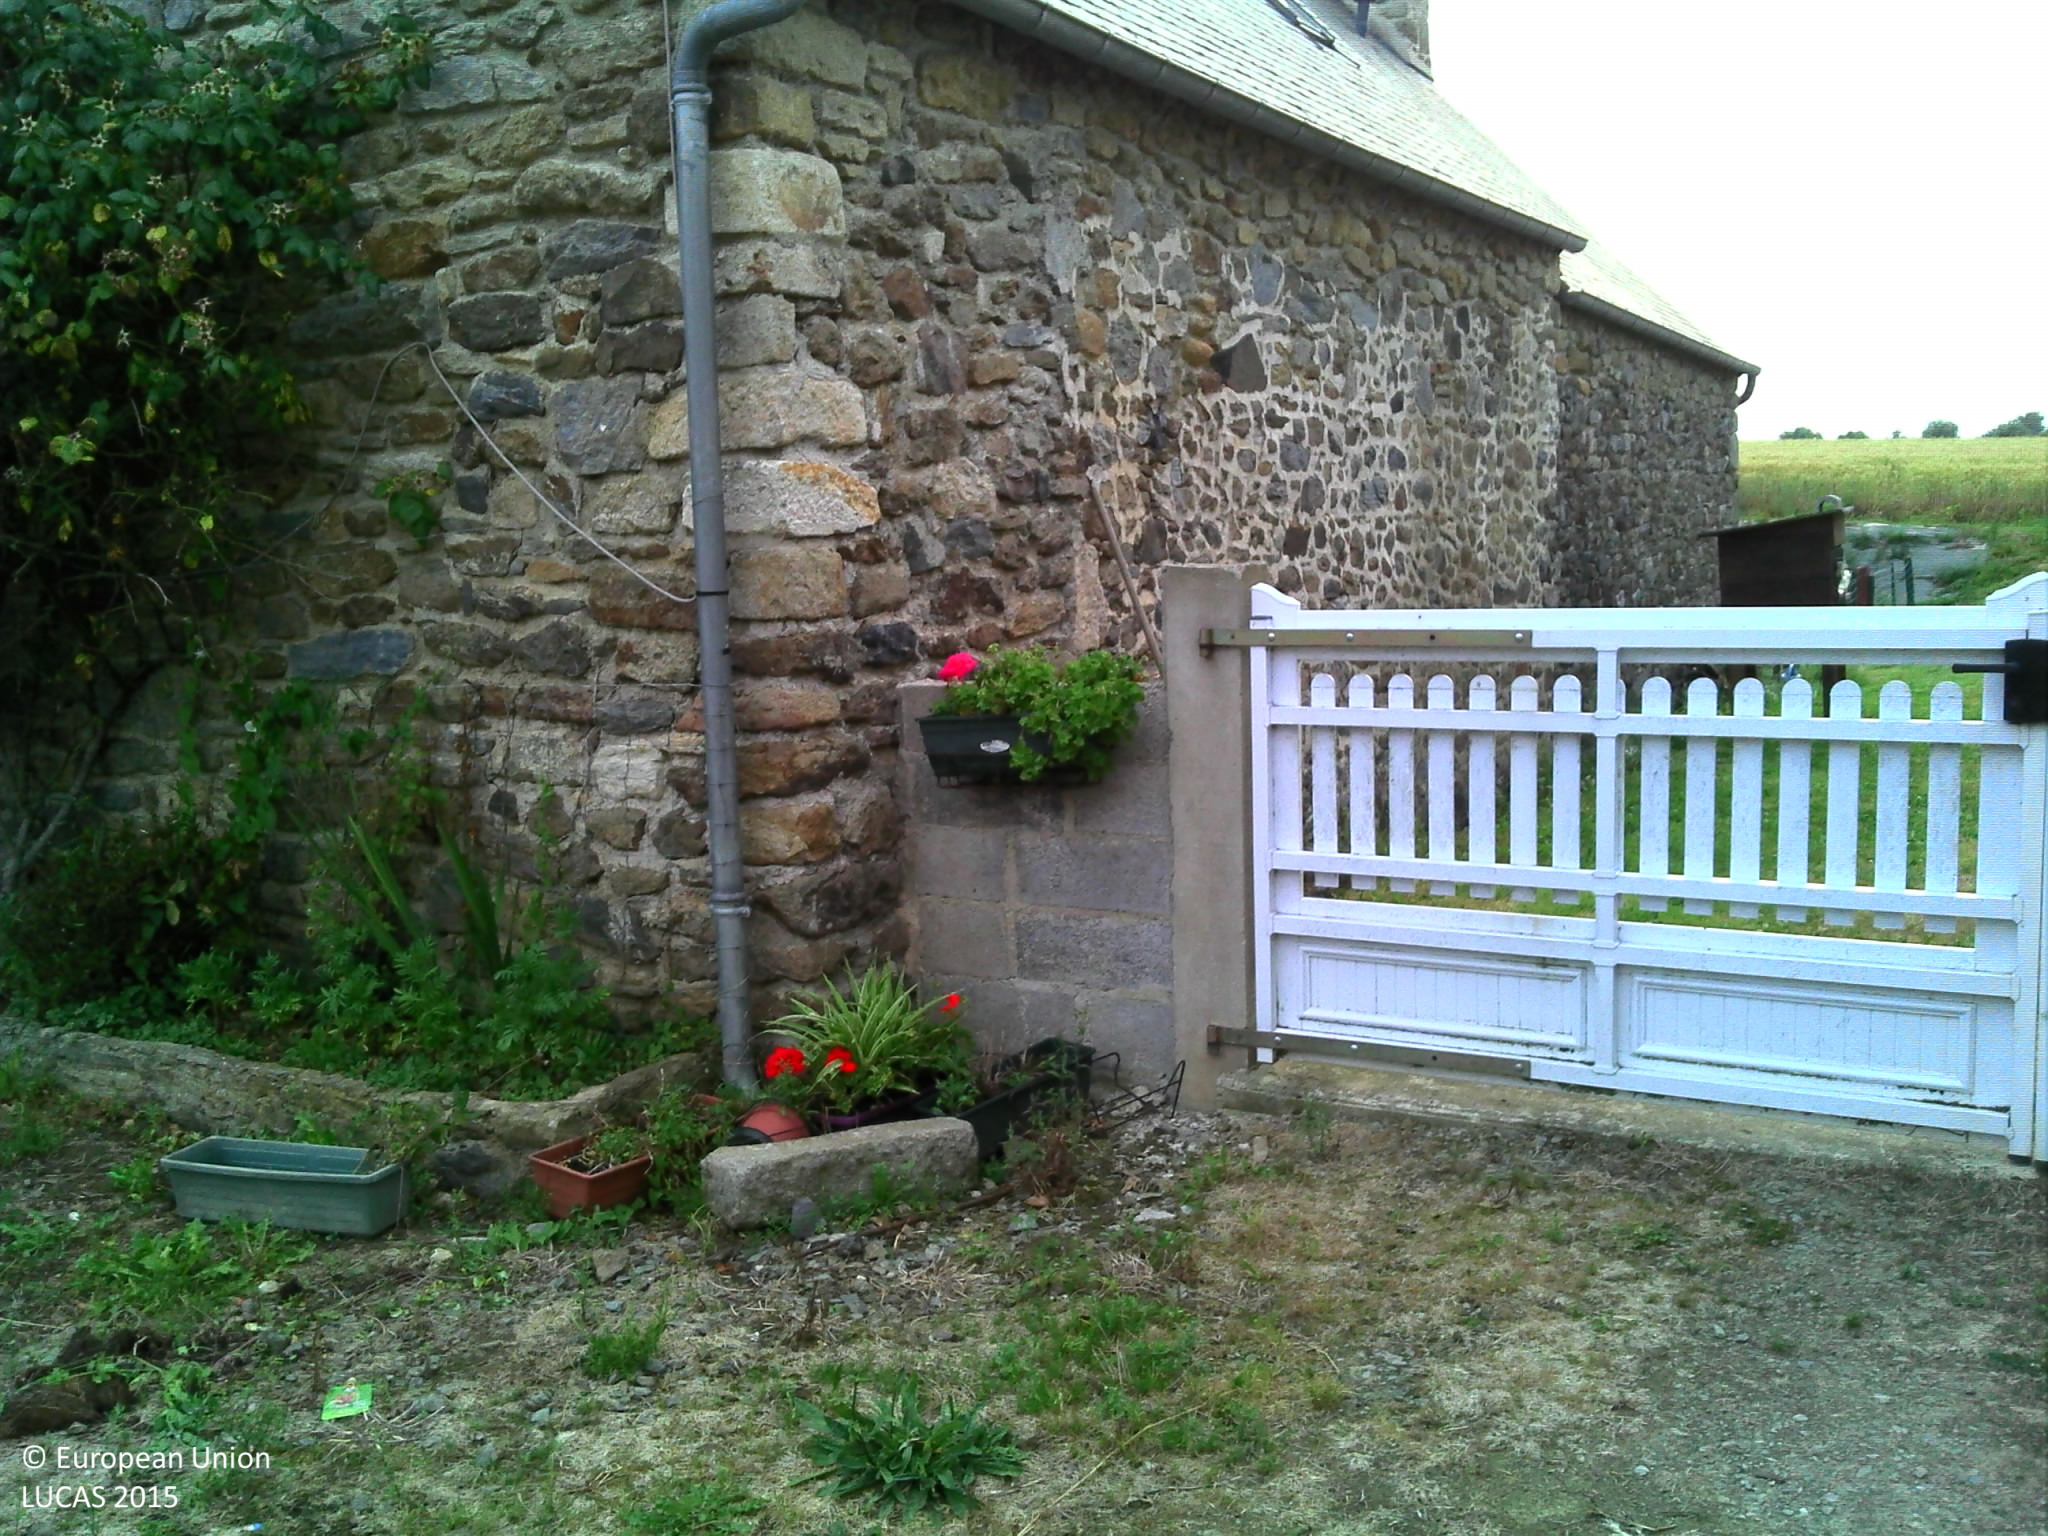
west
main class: Grassland
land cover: Grassland without tree/shrub cover
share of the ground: > 75 %
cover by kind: herbaceous plants 85 %, unconsolidated bare surface 15 %
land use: Residential
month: July
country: FR
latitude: 48.5459
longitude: -2.1805
